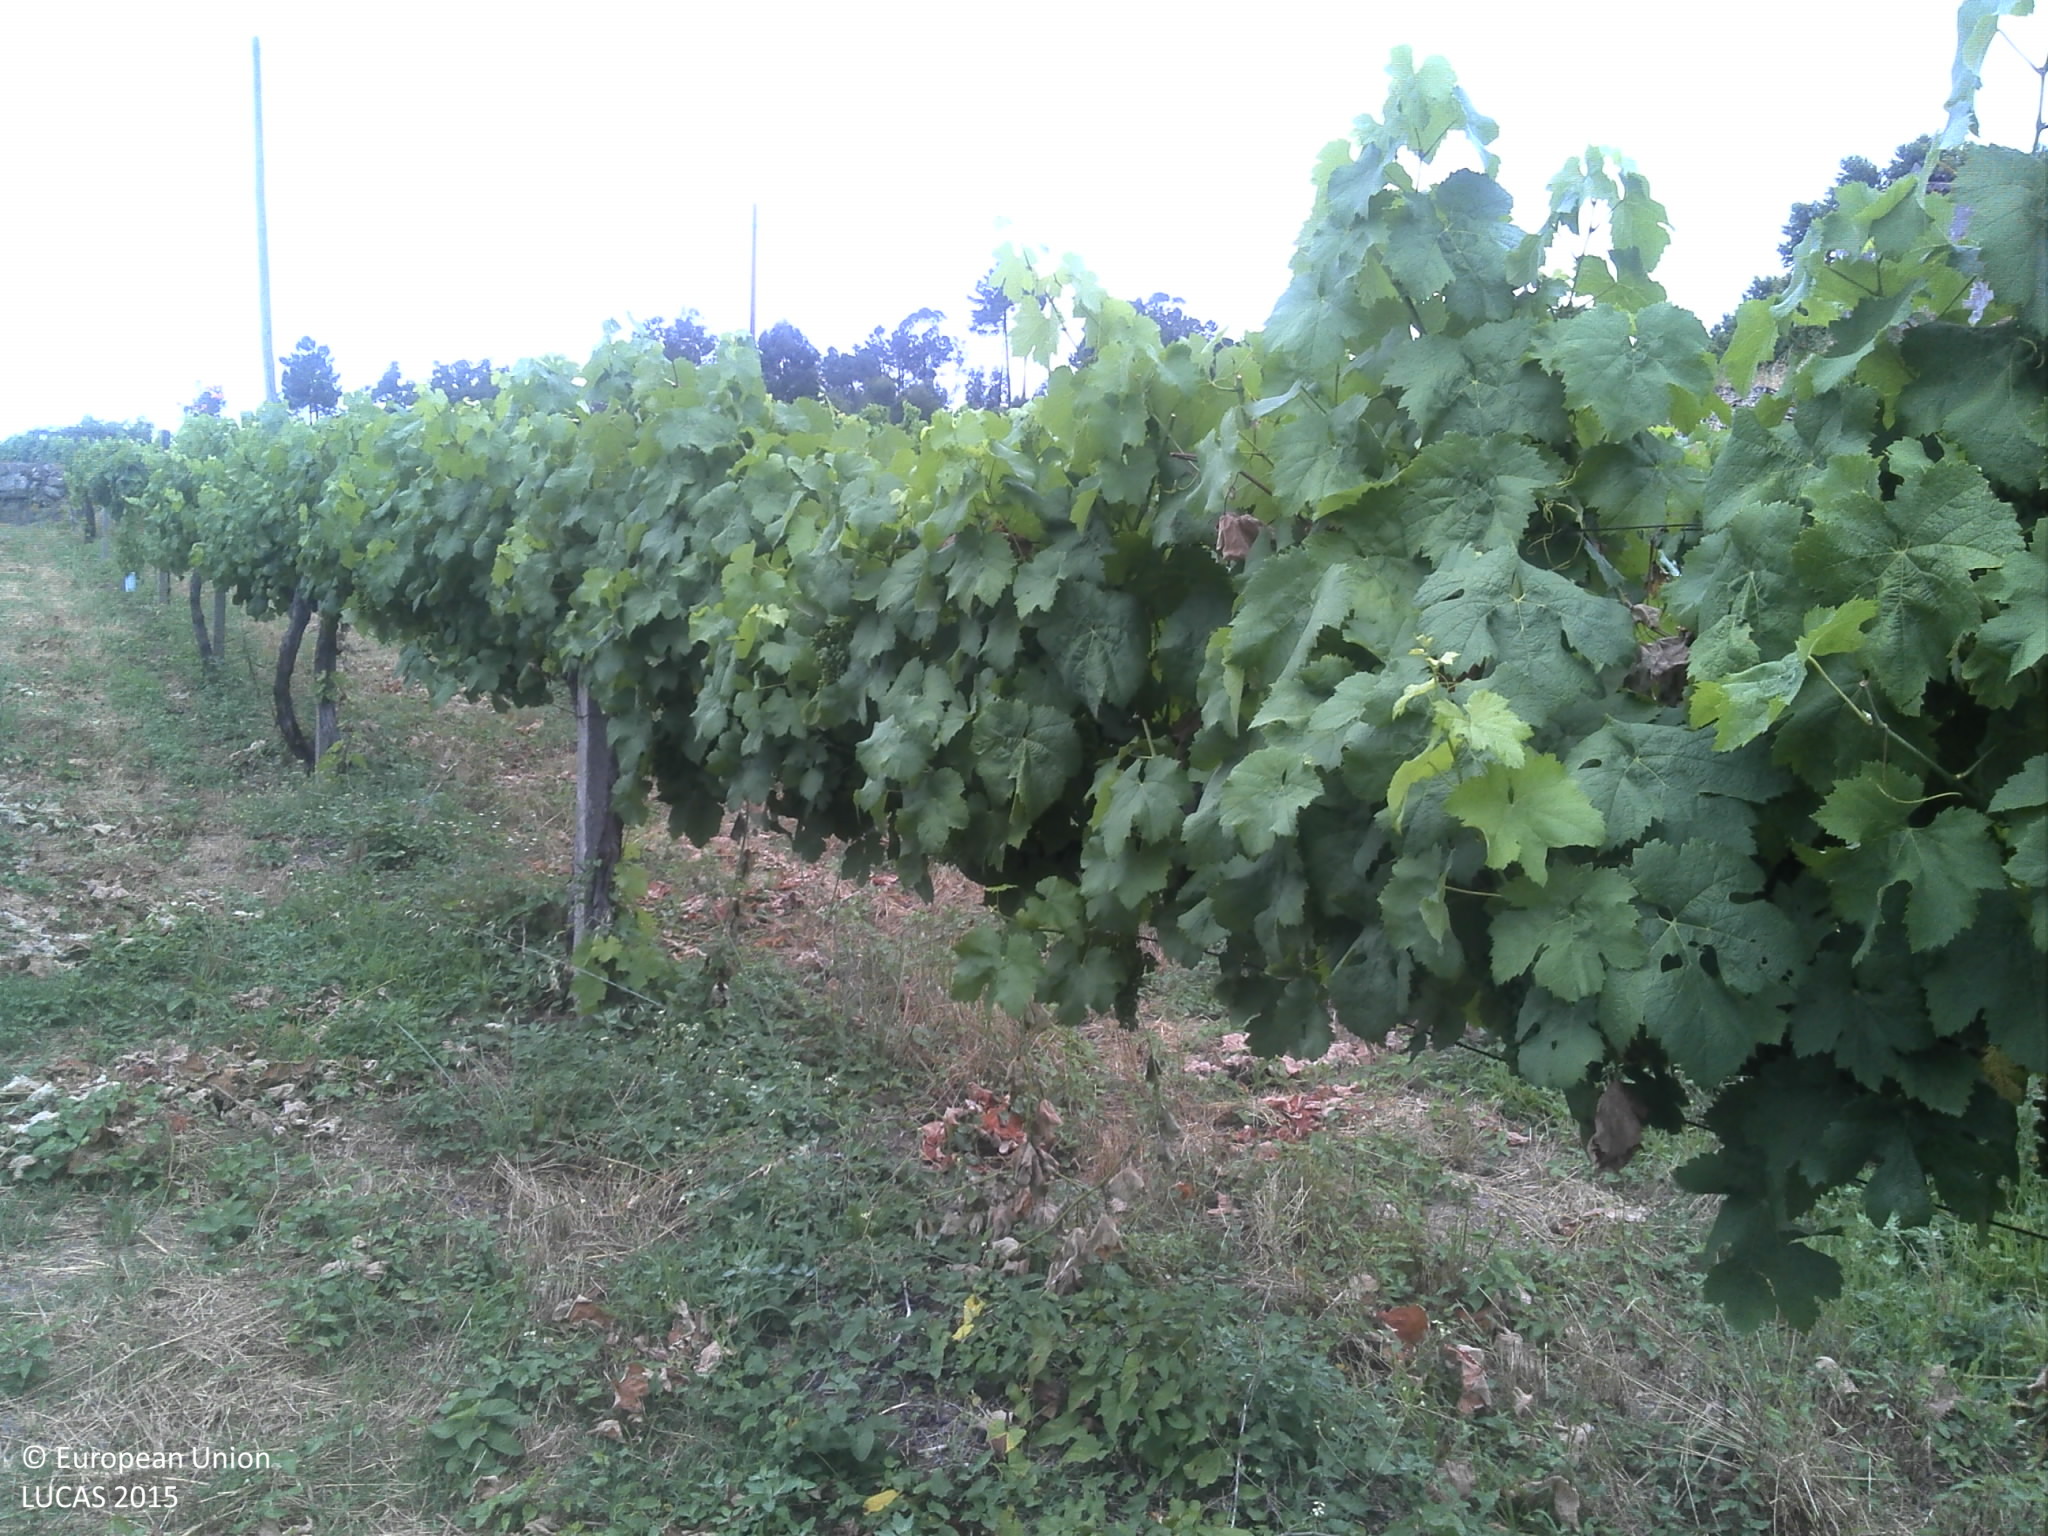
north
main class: Cropland
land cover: Vineyards
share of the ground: 25 - 50 %
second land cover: Grassland without tree/shrub cover
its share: 50 - 75 %
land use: Agriculture (excluding fallow land and kitchen gardens)
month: June
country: PT
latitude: 41.2345
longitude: -8.1687
